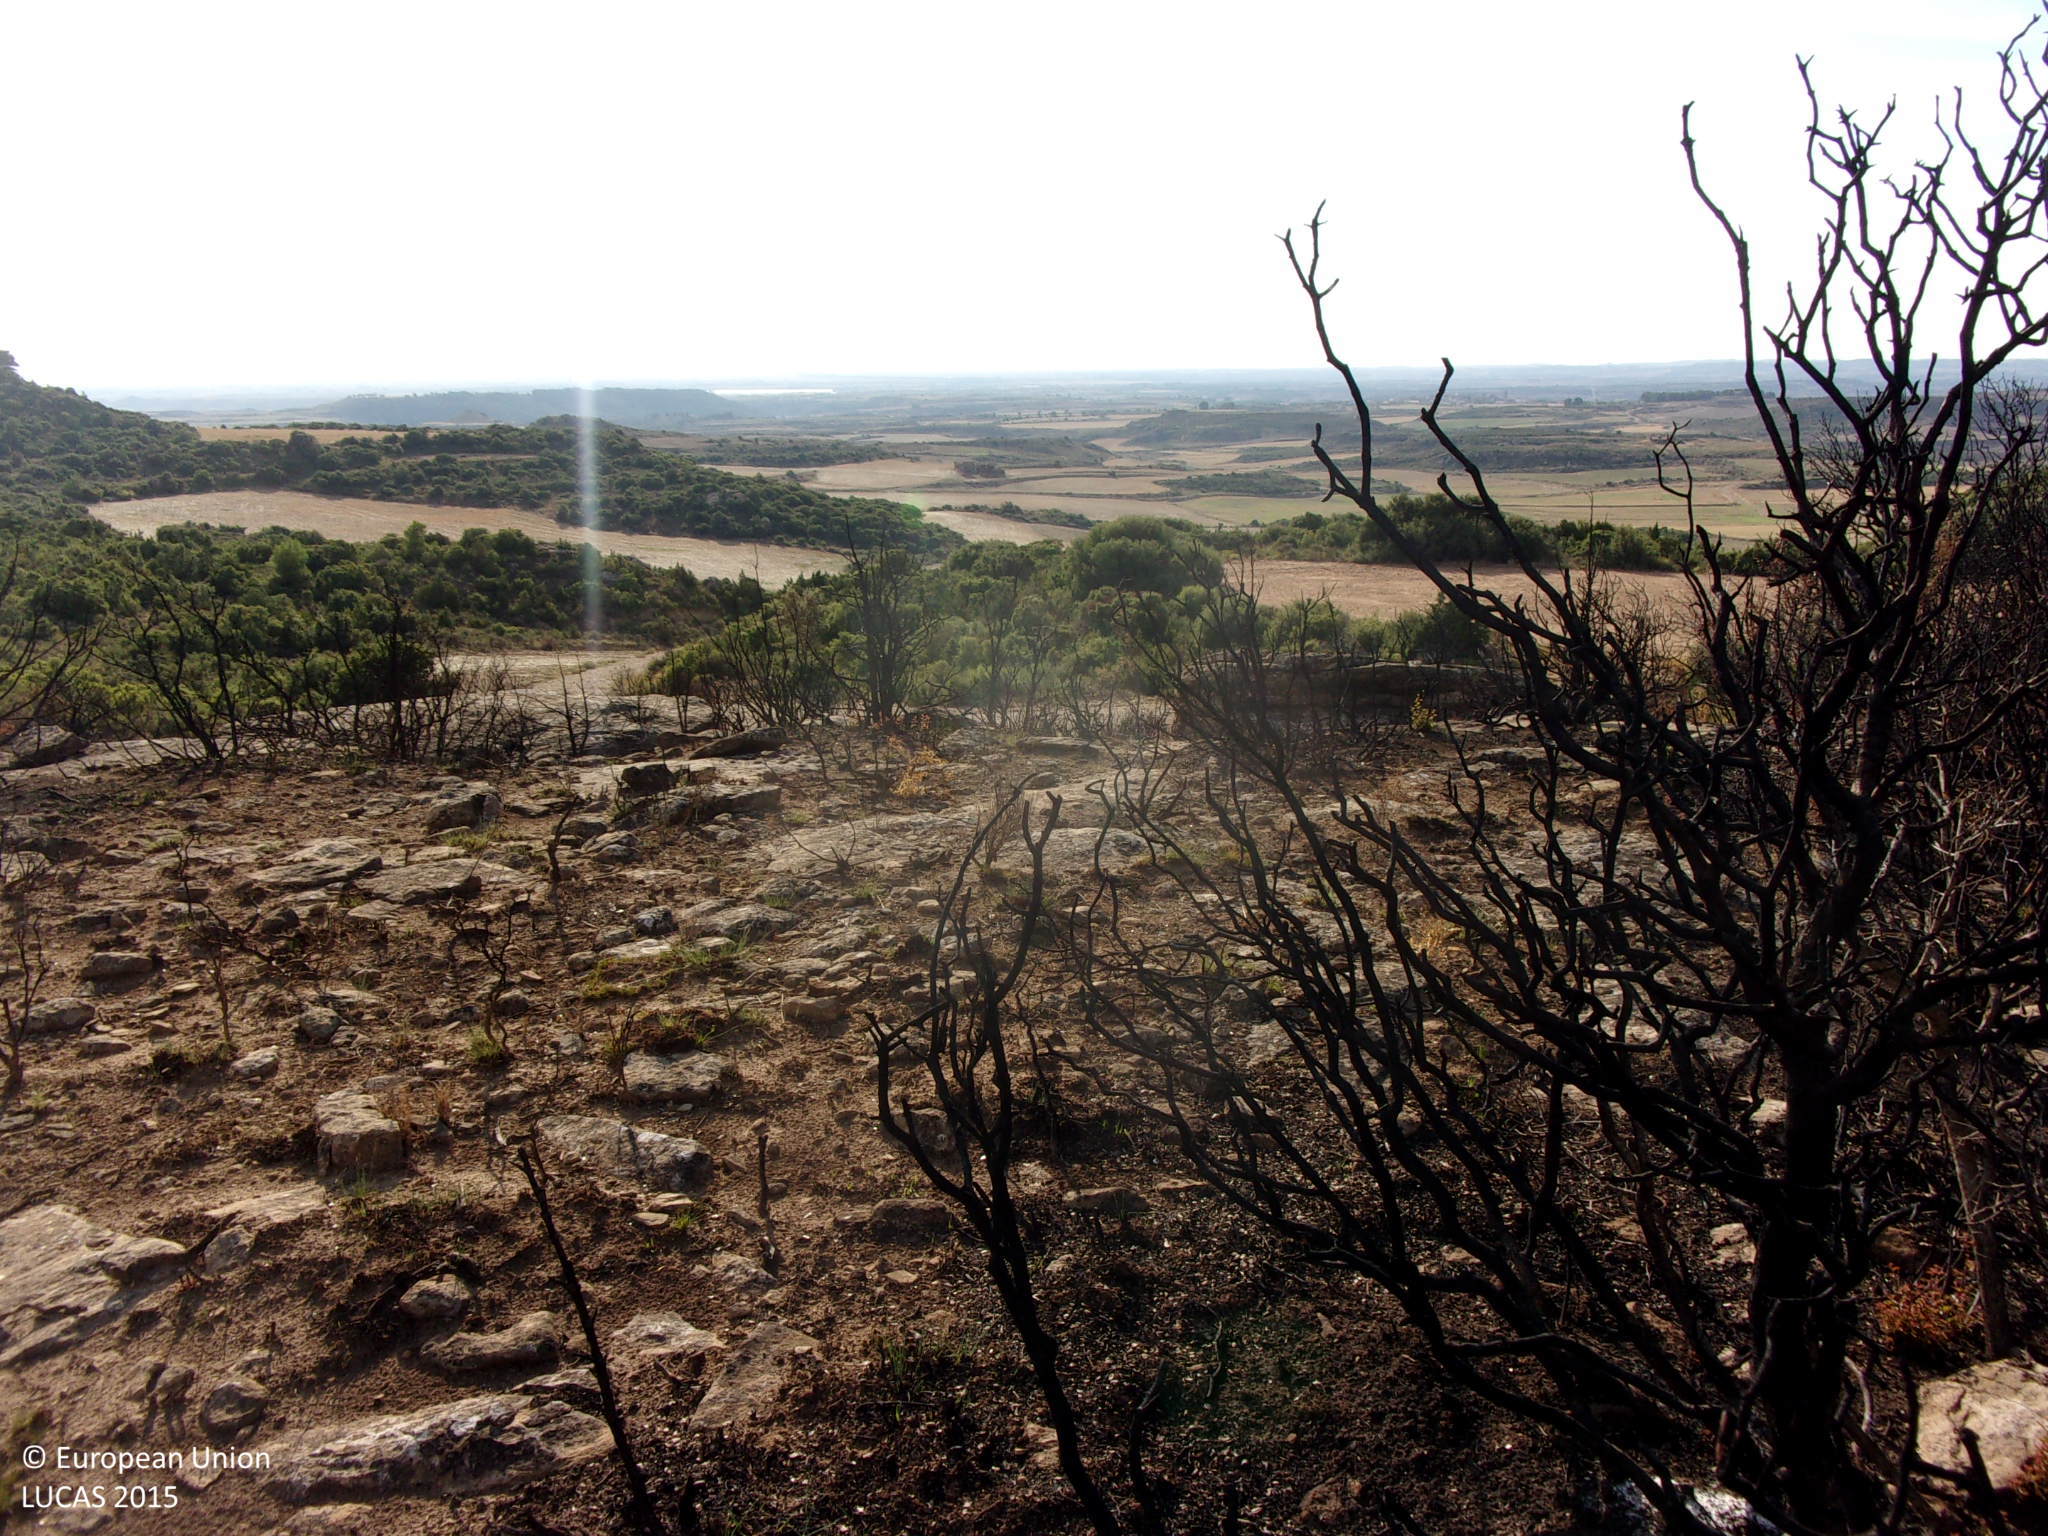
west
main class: Shrubland
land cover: Shrubland without tree cover
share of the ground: 10 - 25 %
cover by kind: unconsolidated bare surface 90 %, shrubs 10 %
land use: Semi-natural and natural areas not in use
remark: Burnt area
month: August
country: ES
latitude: 42.2100
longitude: -1.0629
